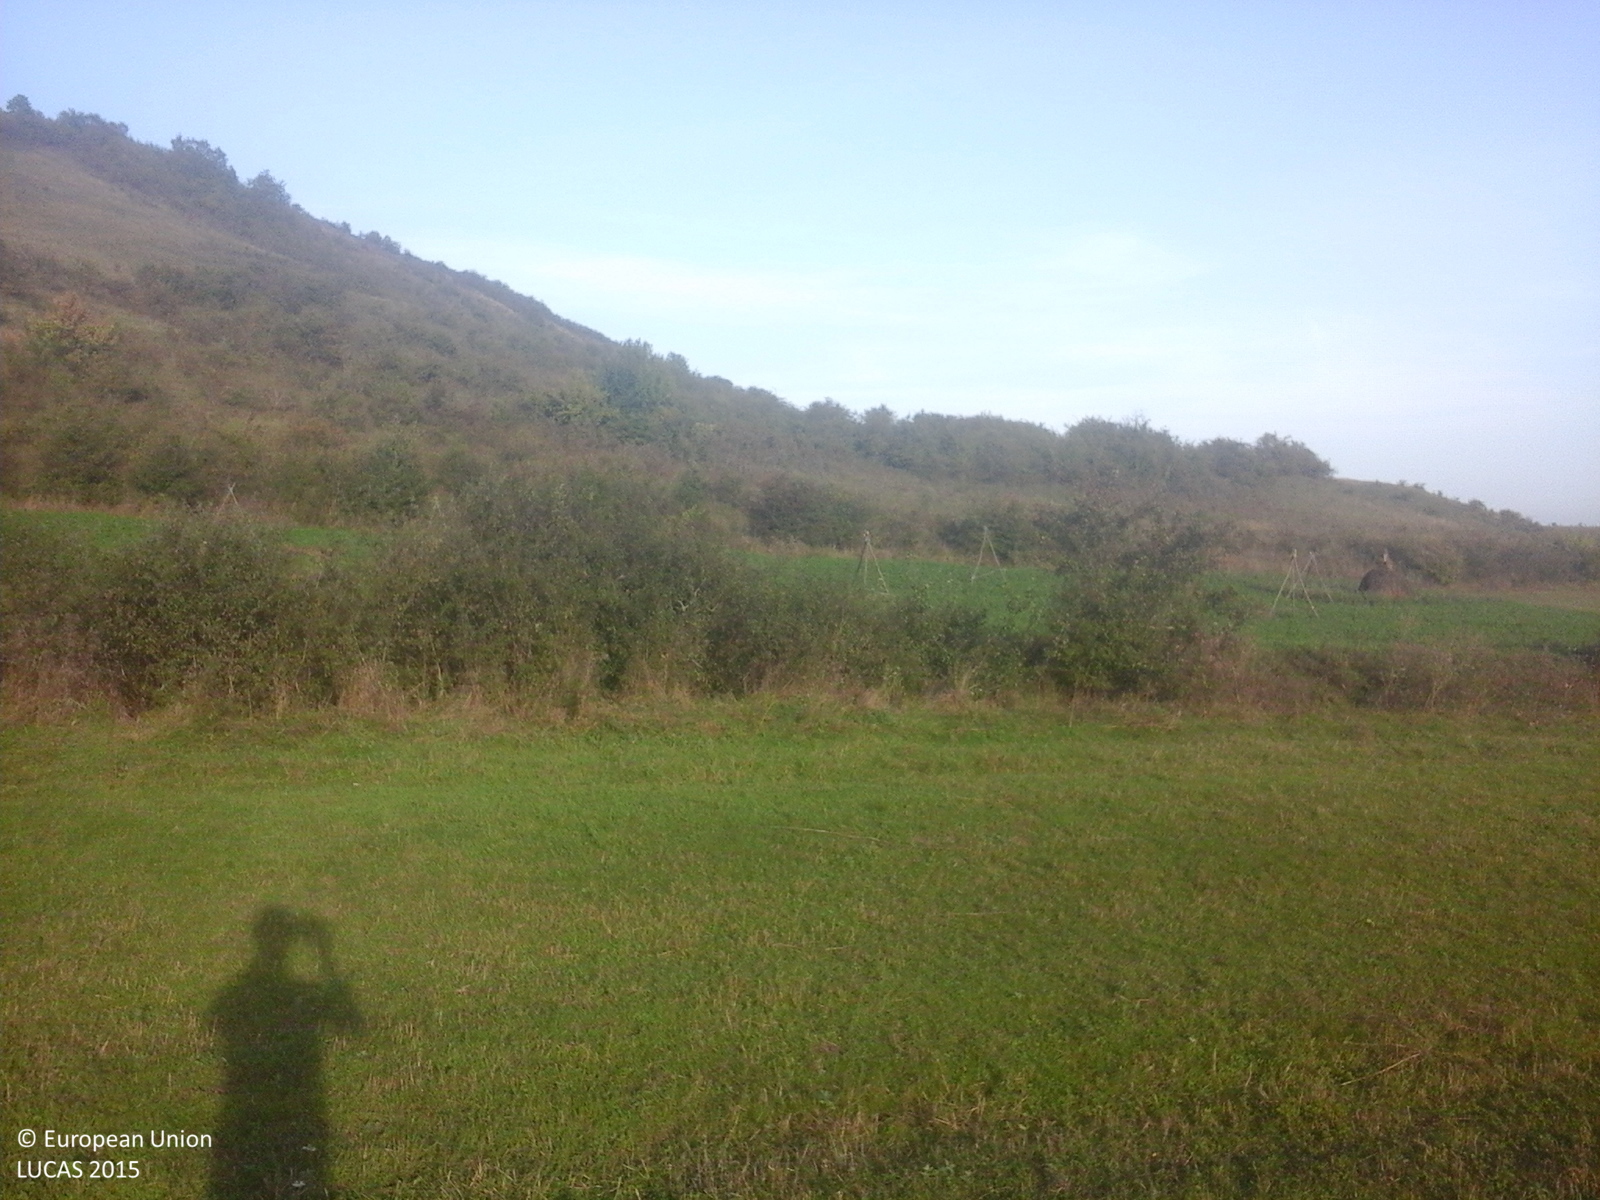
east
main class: Grassland
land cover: Grassland without tree/shrub cover
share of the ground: > 75 %
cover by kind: herbaceous plants 100 %
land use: Agriculture (excluding fallow land and kitchen gardens)
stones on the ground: < 10 %
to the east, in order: Grassland without tree/shrub cover; Ditches and canals; Lucerne; Grassland with sparse tree/shrub cover
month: September
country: RO
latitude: 46.7854
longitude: 23.3624
